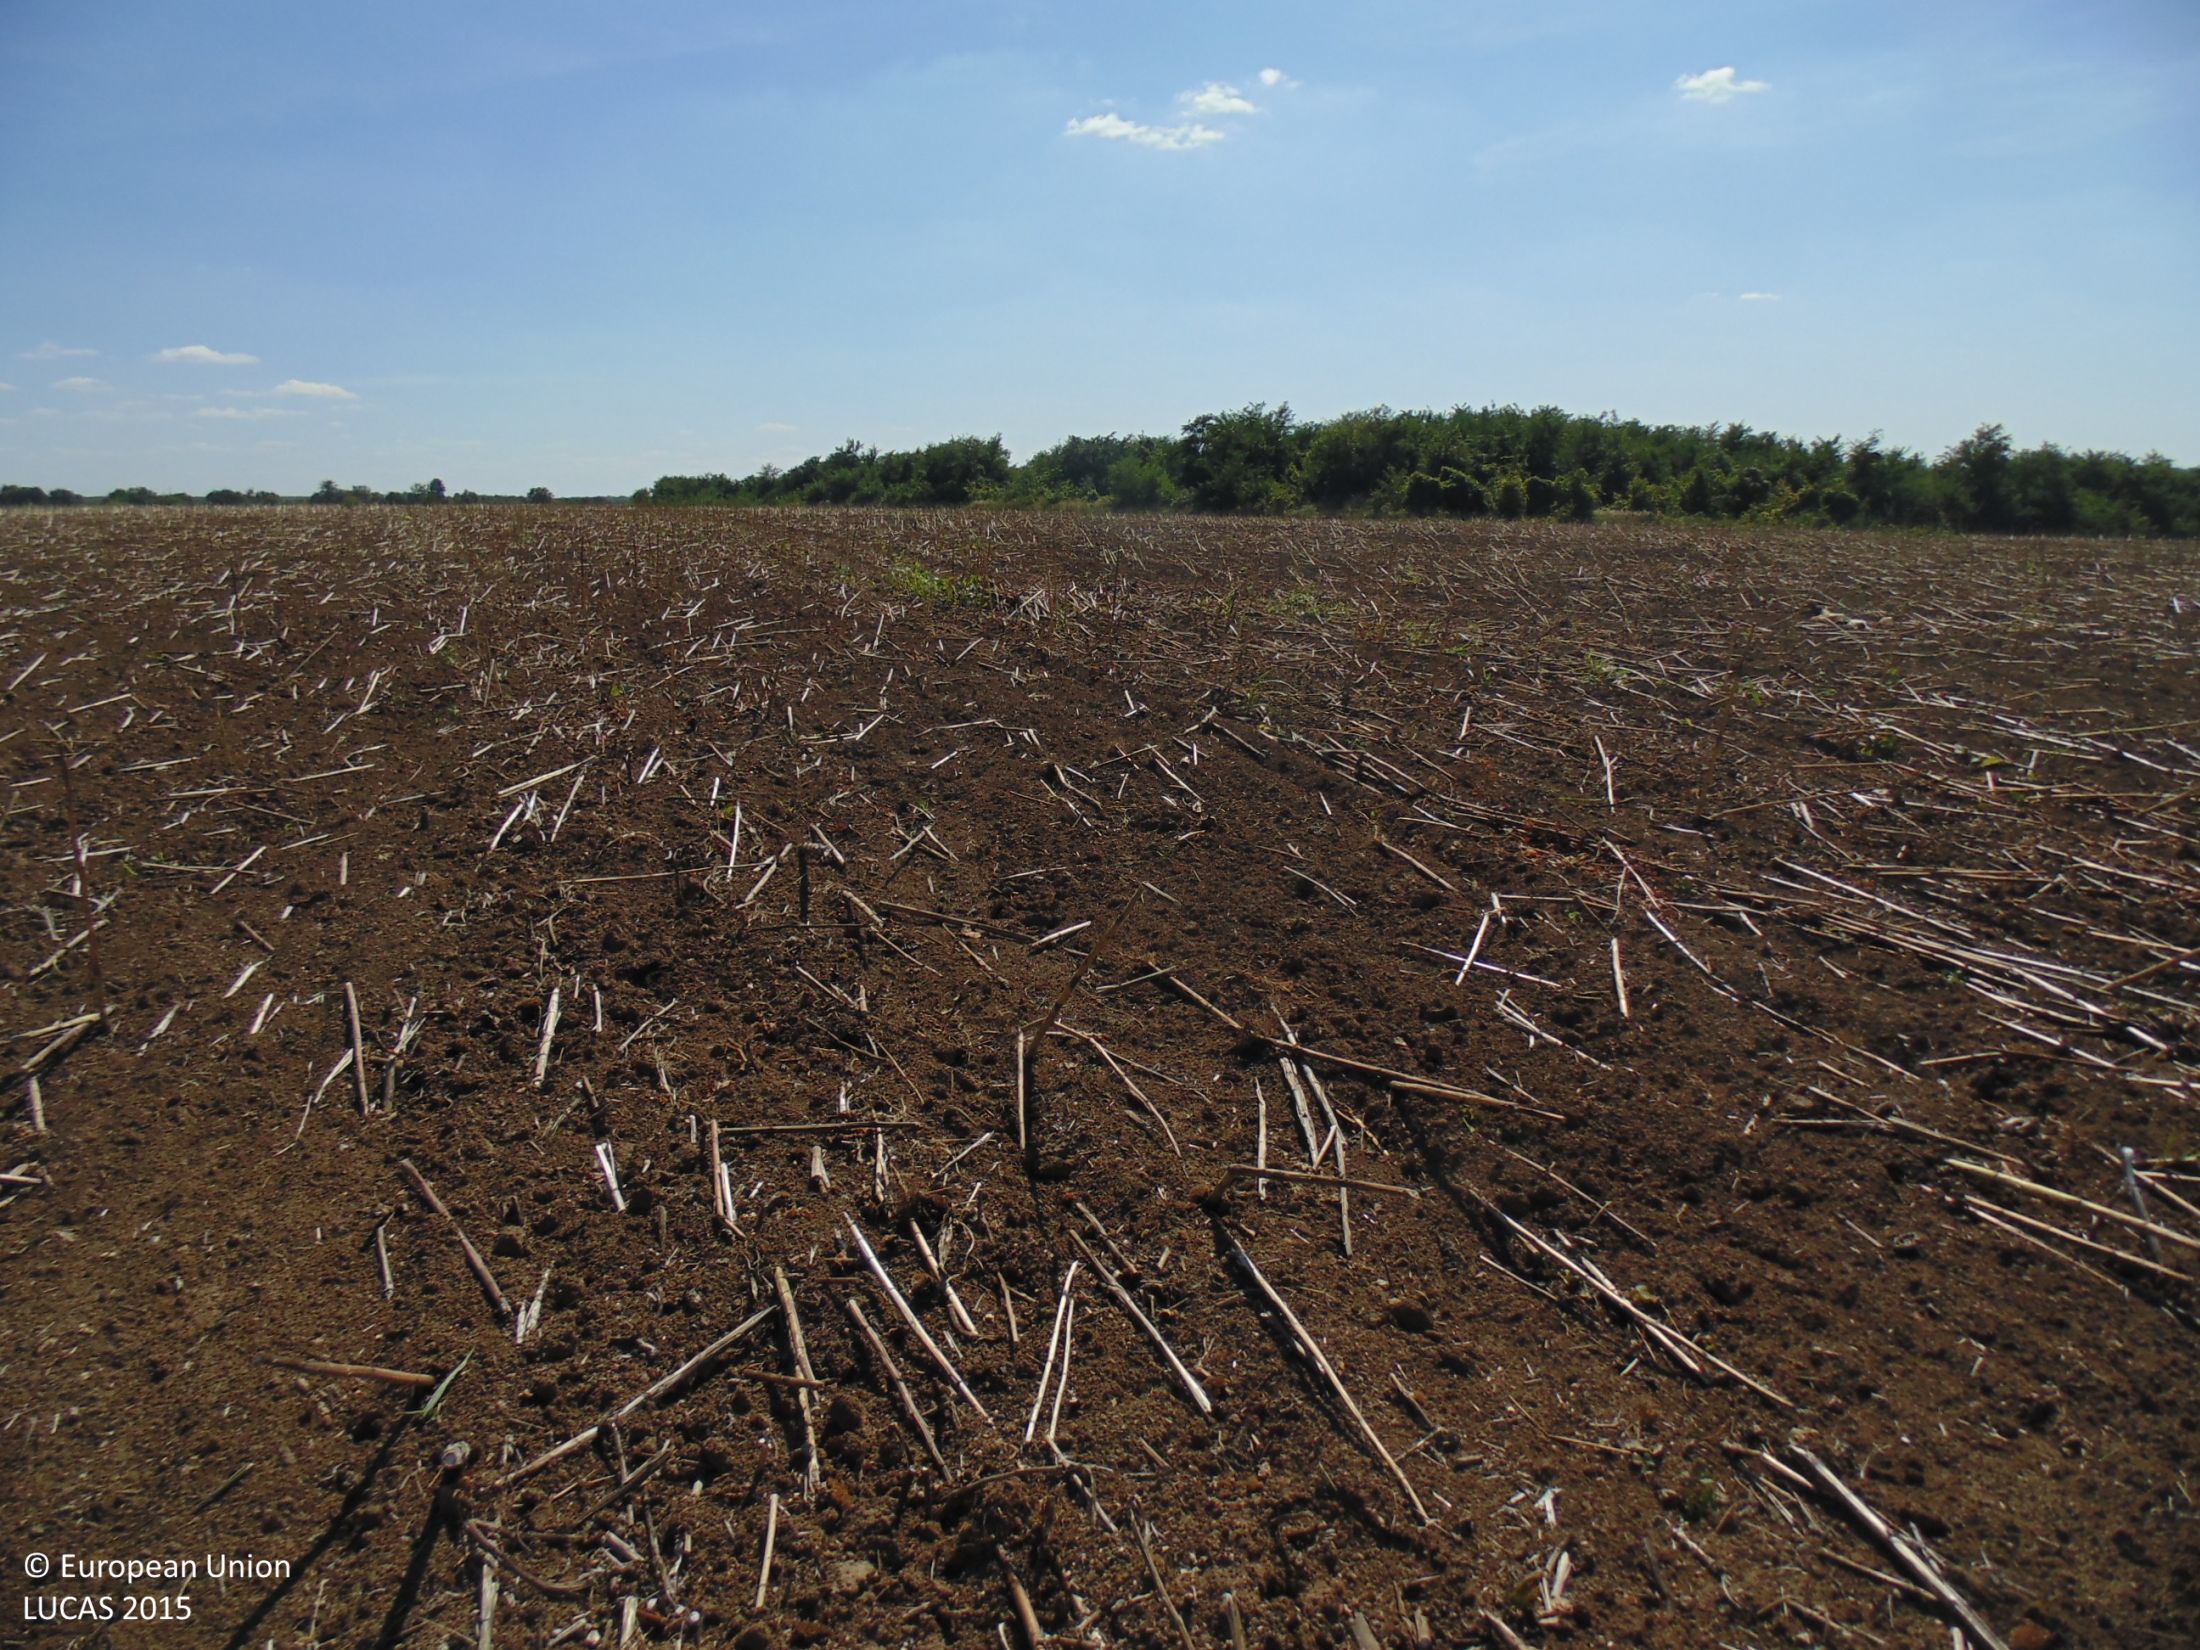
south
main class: Cropland
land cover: Sunflower
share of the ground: < 10 %
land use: Agriculture (excluding fallow land and kitchen gardens)
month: September
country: BG
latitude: 44.1068
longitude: 26.9260
